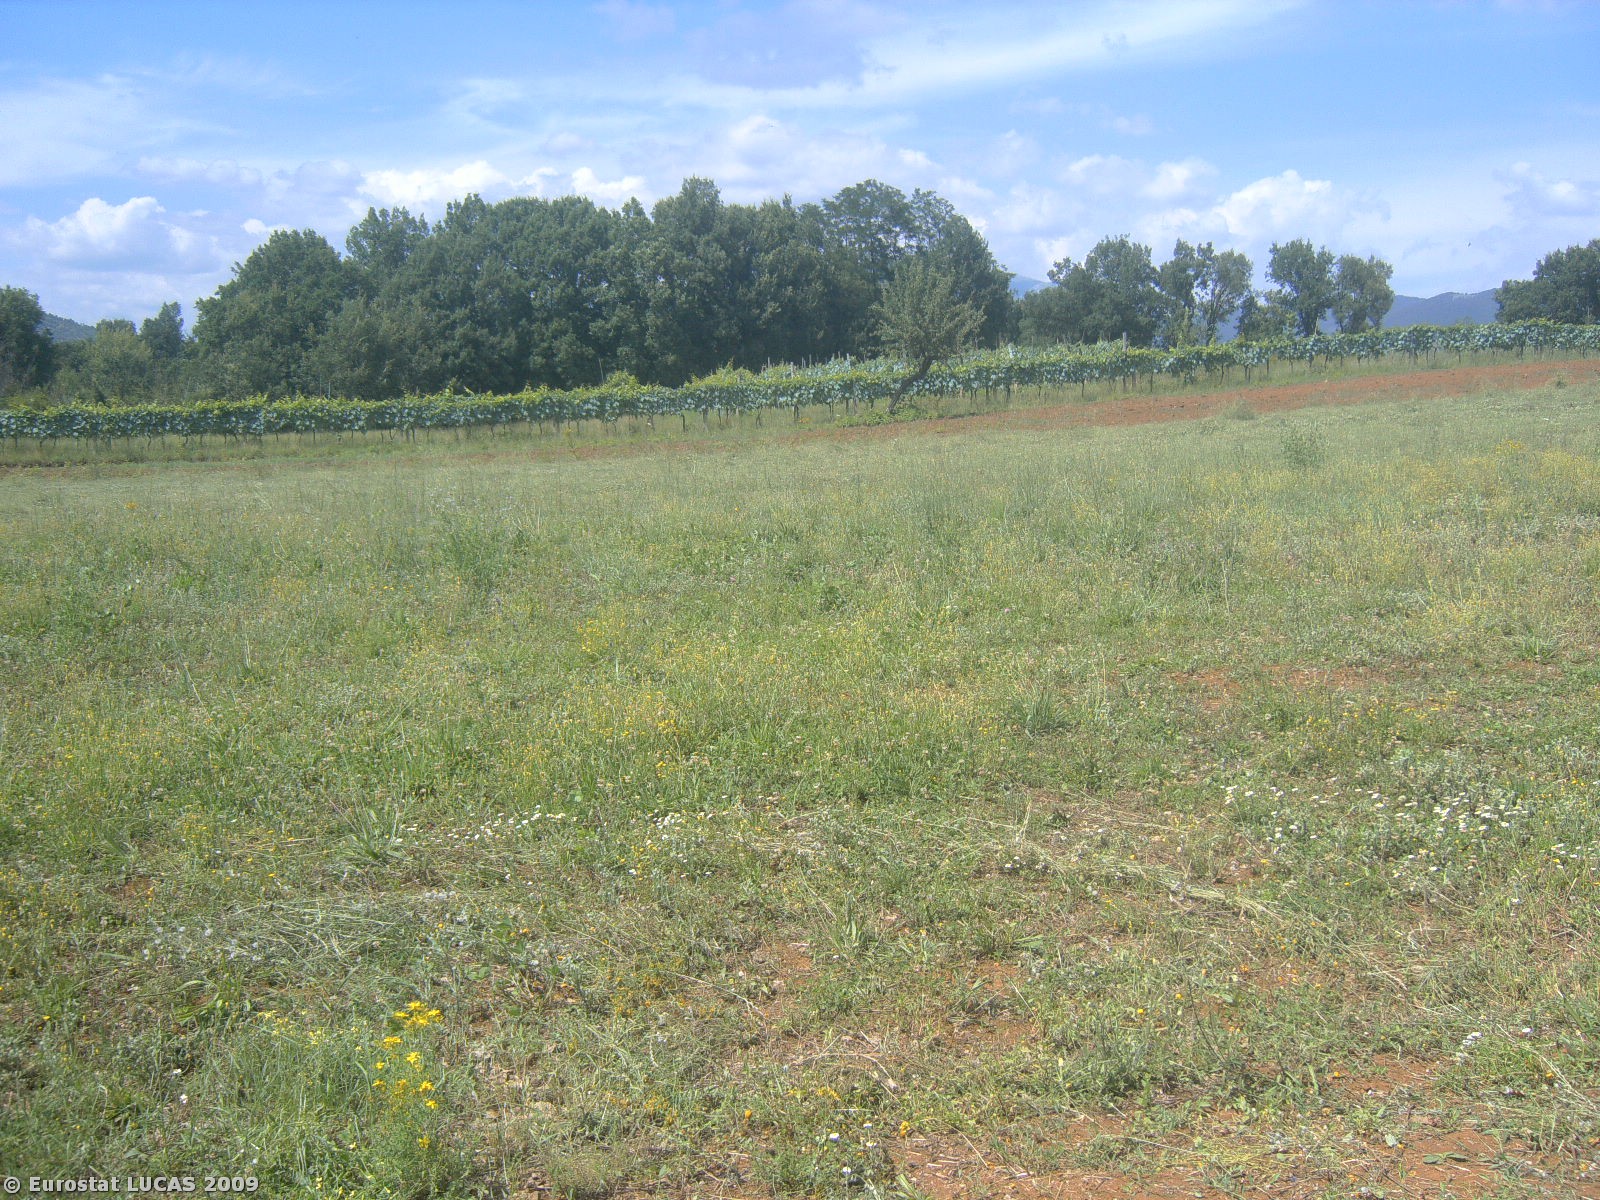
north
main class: Cropland
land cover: Other leguminous and mixtures for fodder
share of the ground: > 75 %
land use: Agriculture (excluding fallow land and kitchen gardens)
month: July
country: IT
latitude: 41.6760
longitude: 13.3628
